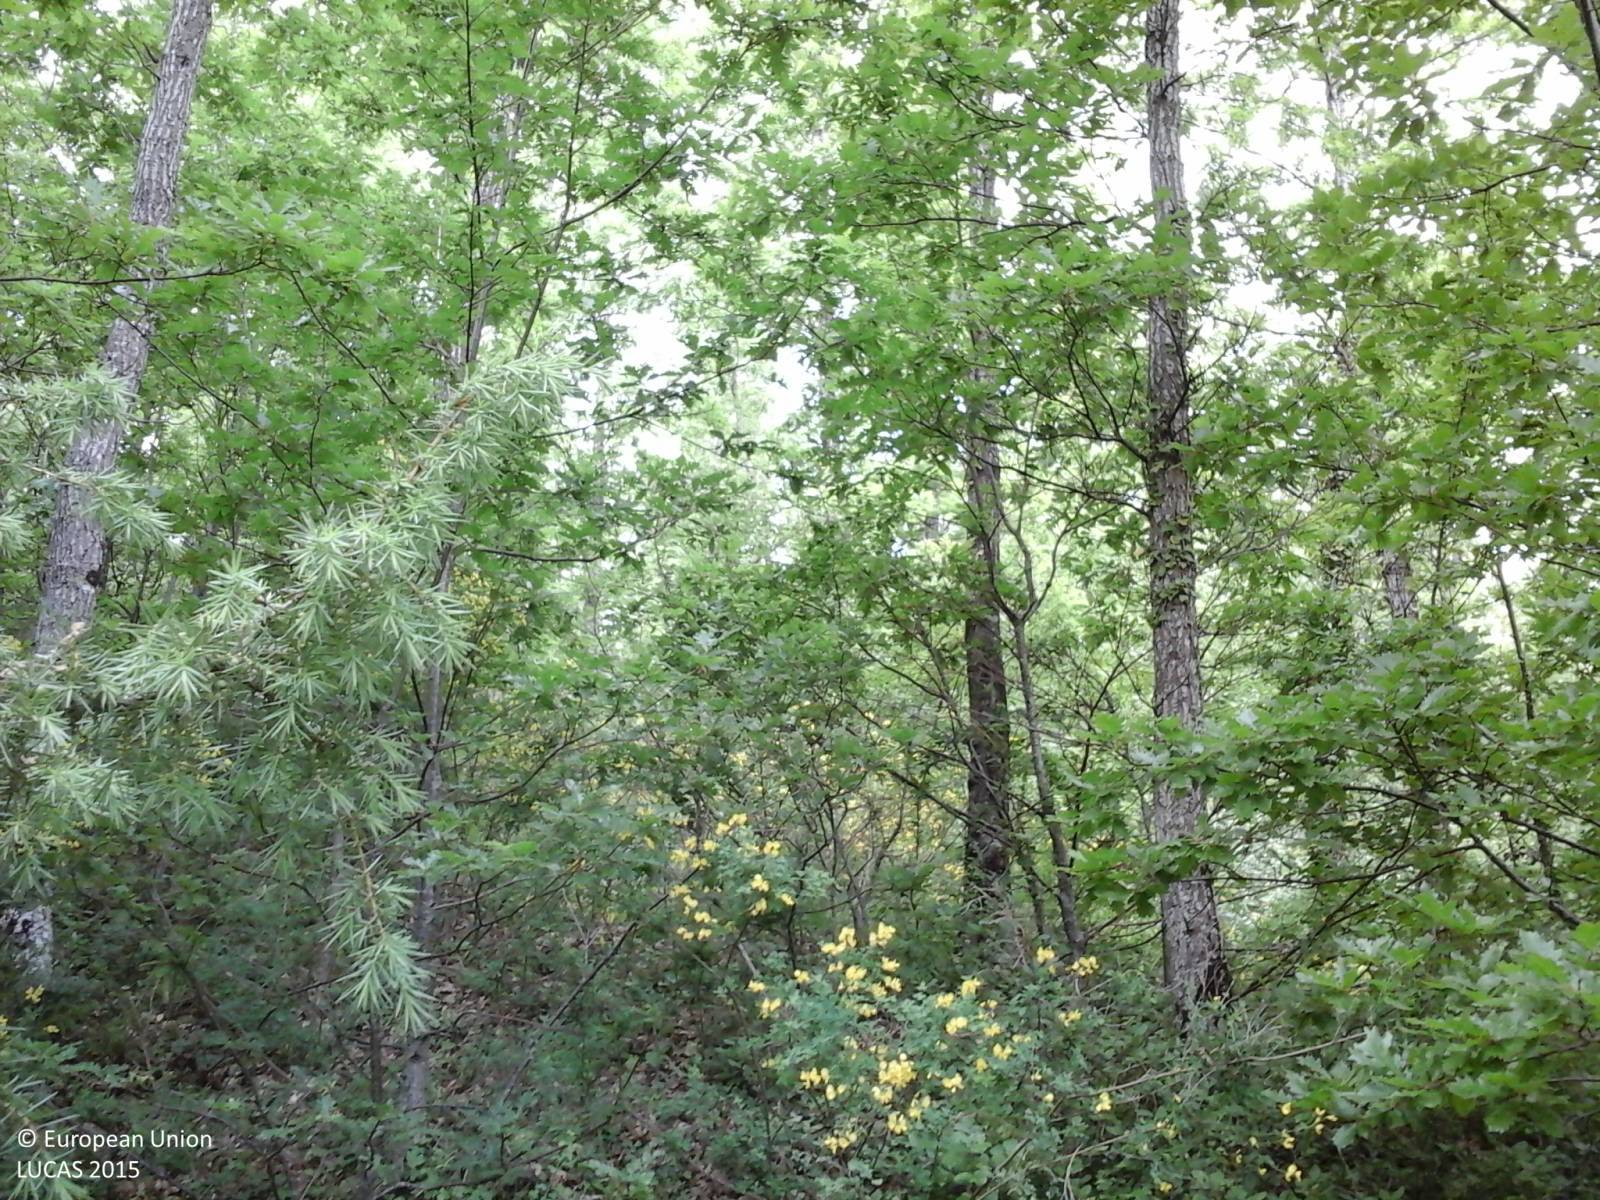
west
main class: Woodland
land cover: Broadleaved woodland
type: thermophilous deciduous forest
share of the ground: > 75 %
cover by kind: broadleaved forest trees 95 %, shrubs 5 %
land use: Forestry
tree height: > 5 m
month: May
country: IT
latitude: 41.8609
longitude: 14.2141
